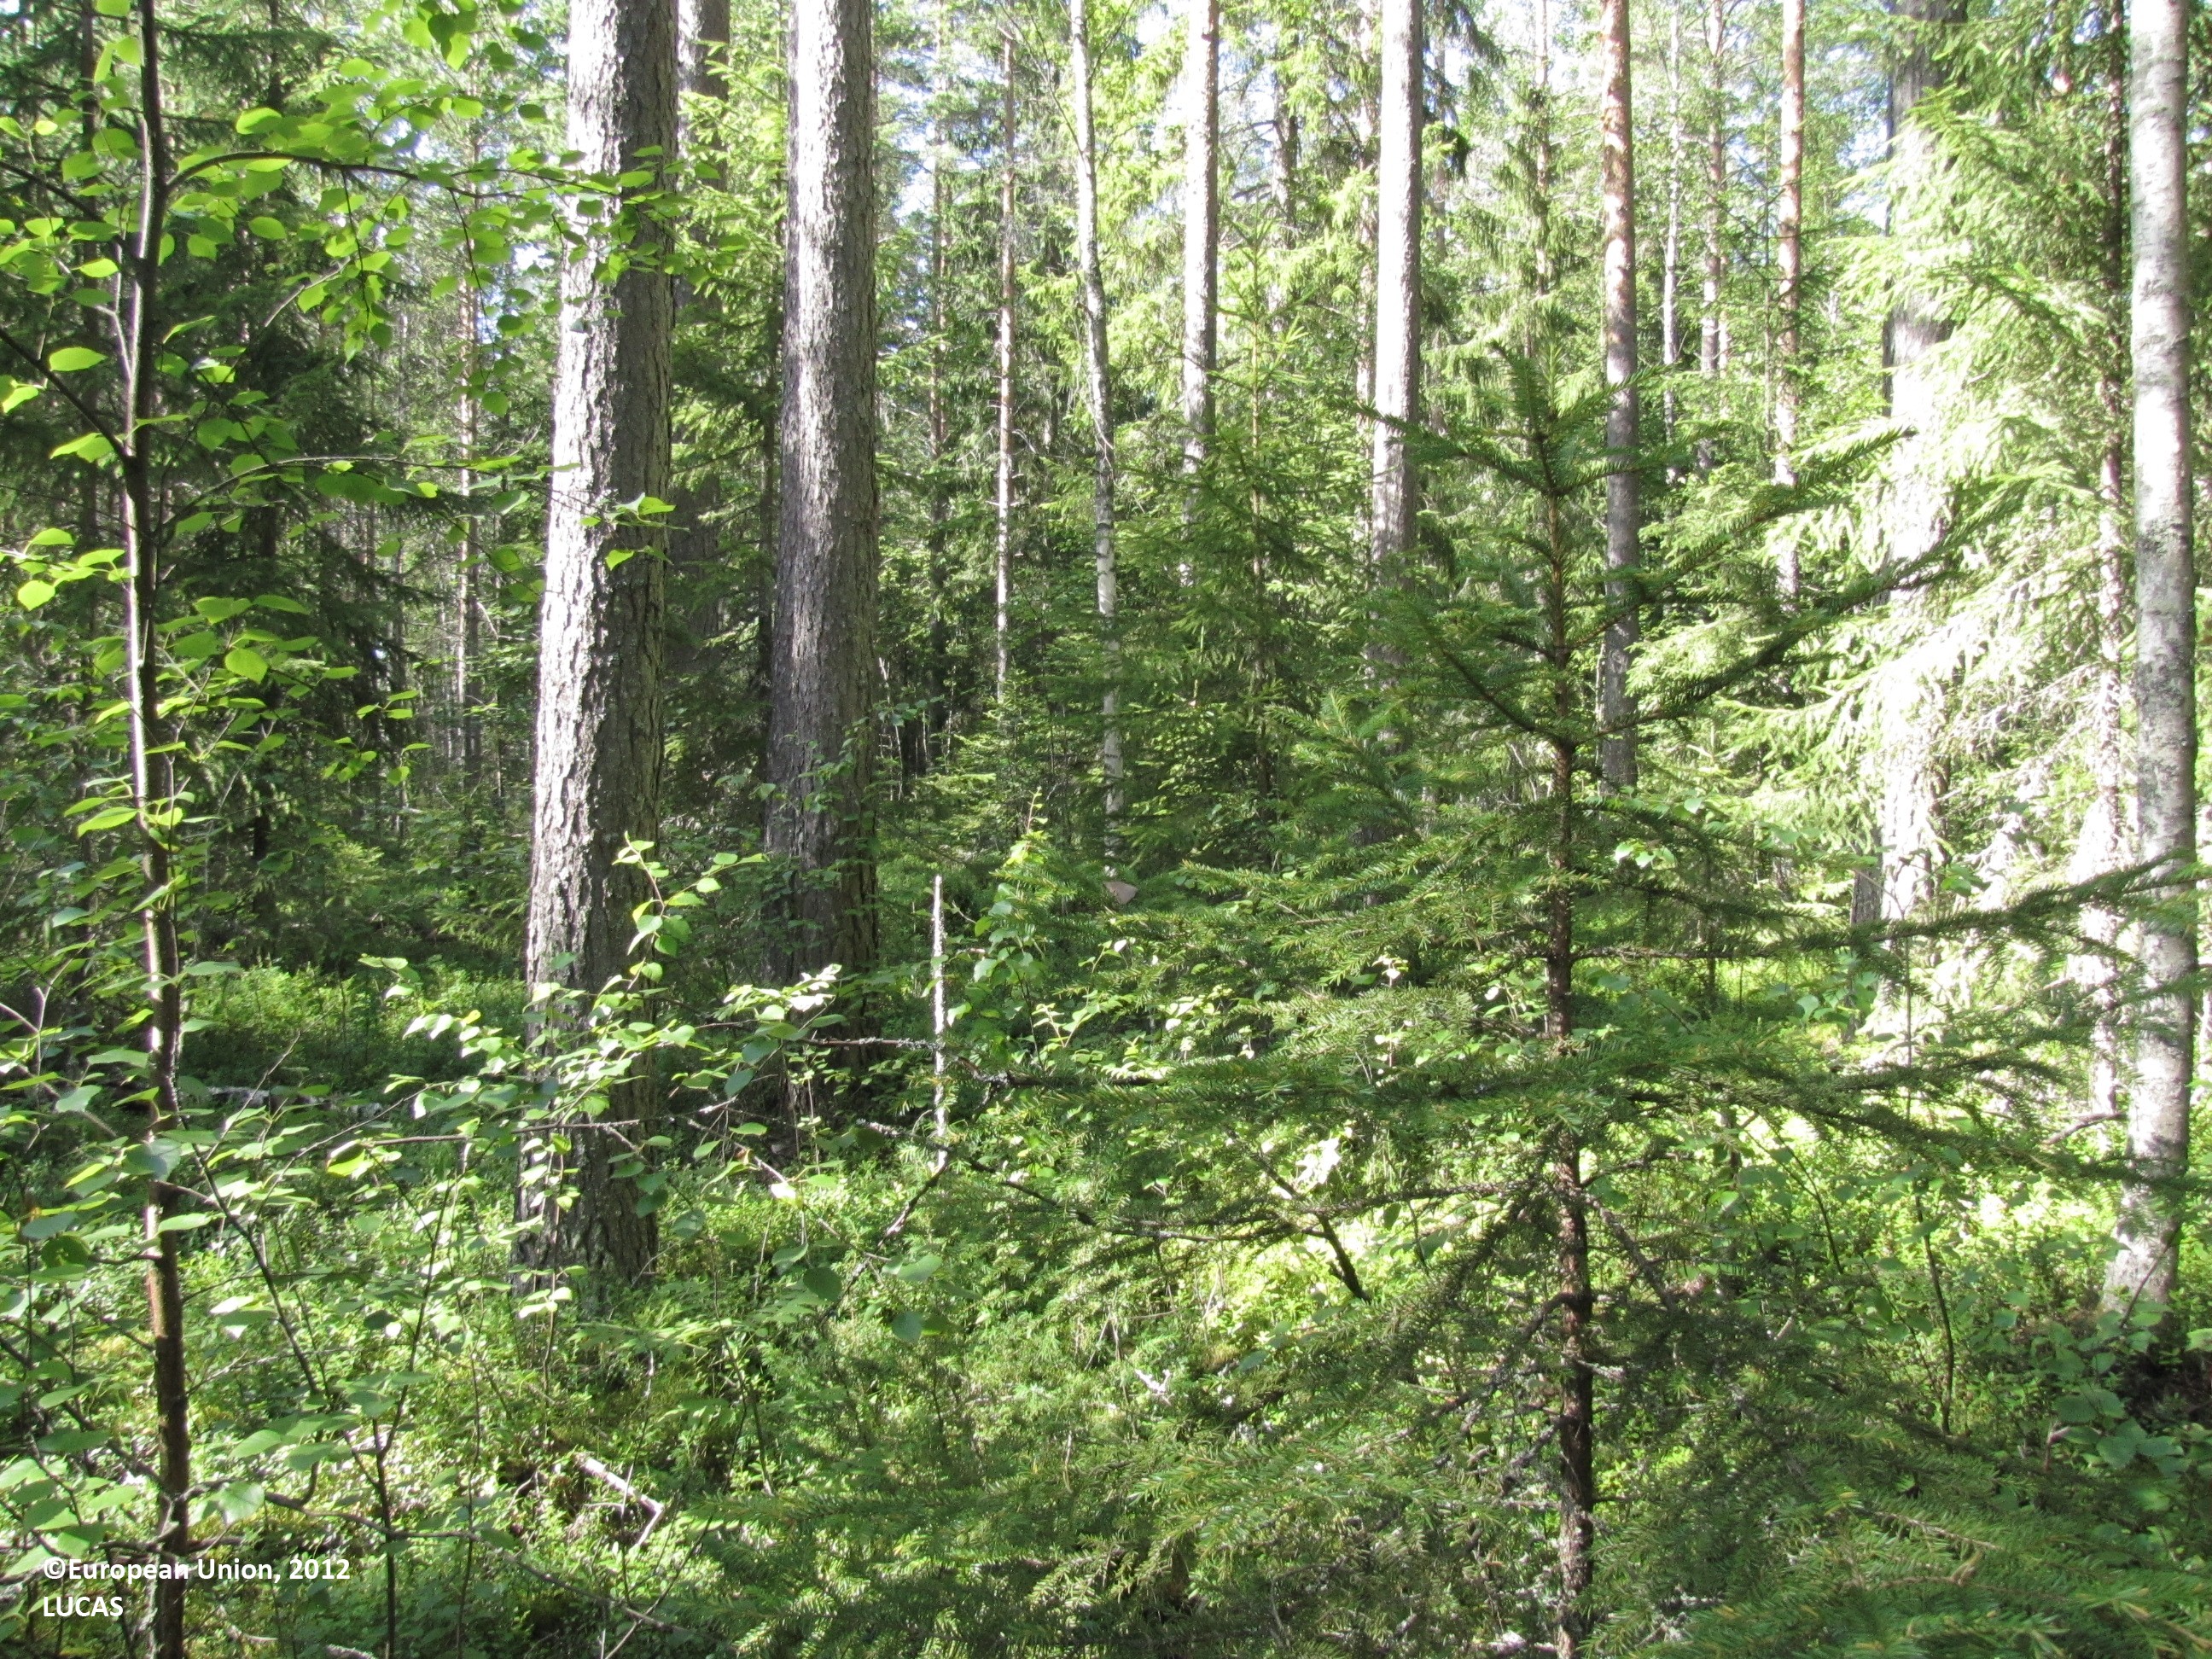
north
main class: Woodland
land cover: Pine dominated coniferous woodland
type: boreal forest
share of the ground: > 75 %
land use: Forestry
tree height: > 5 m
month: July
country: FI
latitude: 62.3515
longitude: 23.0654
